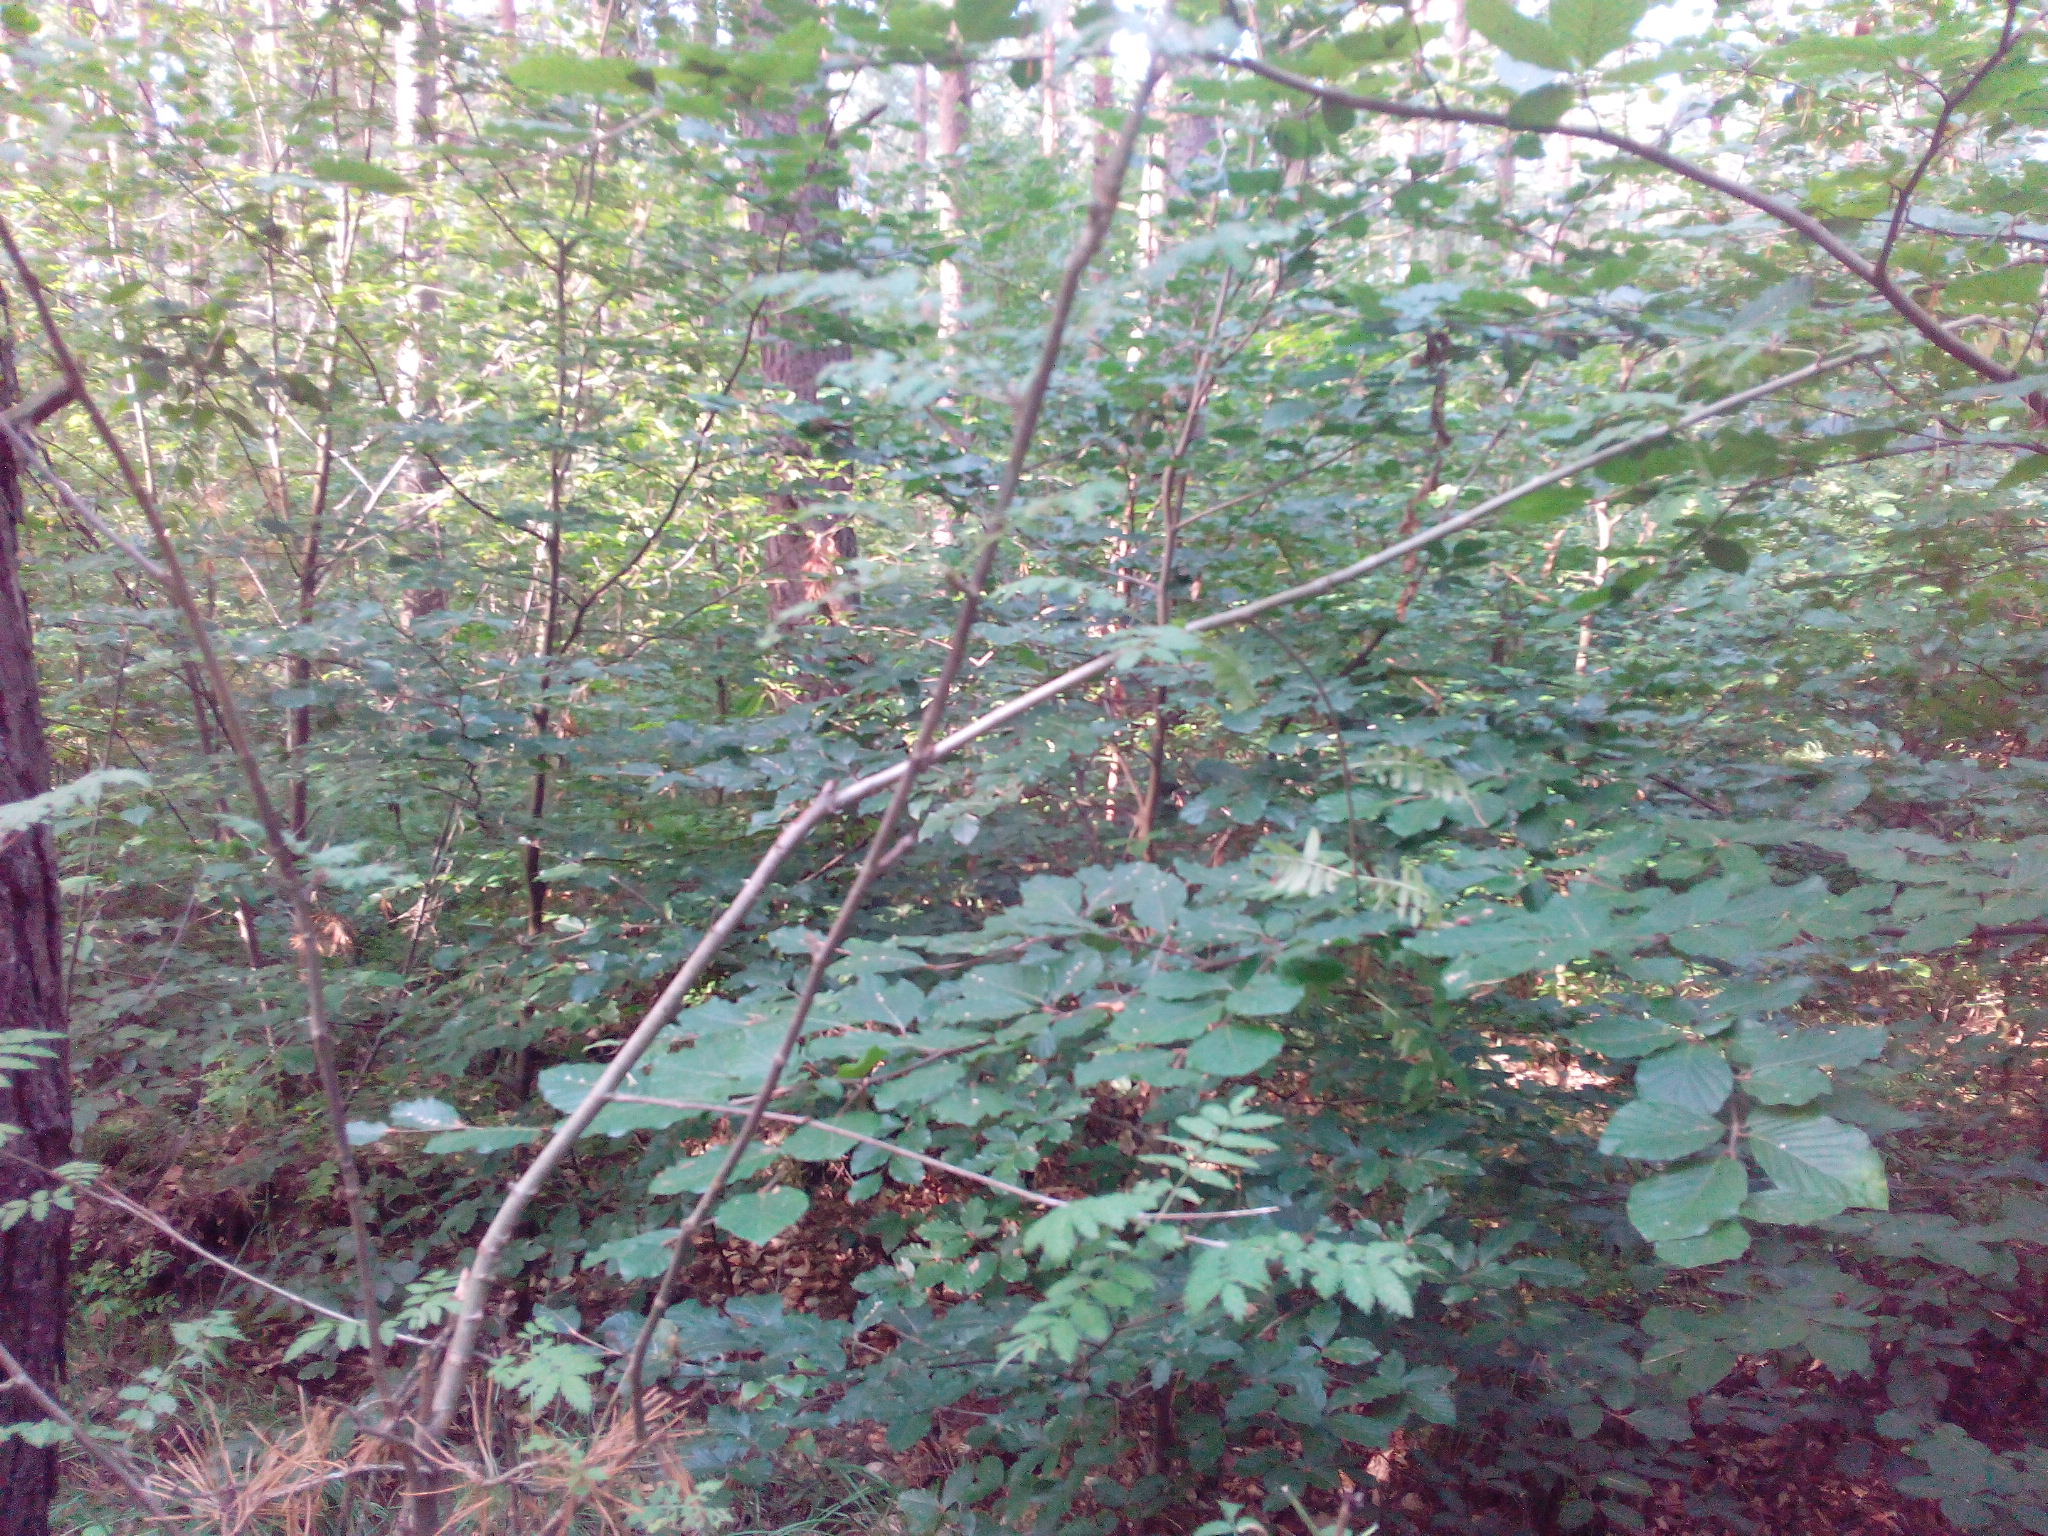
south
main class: Woodland
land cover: Pine dominated mixed woodland
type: hemiboreal forest and nemoral coniferous forest and mixed broadleaved-coniferous forest
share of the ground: > 75 %
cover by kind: coniferous forest trees 45 %, broadleaved forest trees 45 %, shrubs 5 %, herbaceous plants 5 %
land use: Forestry
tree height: > 5 m
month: August
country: DE
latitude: 52.5752
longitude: 9.9262
